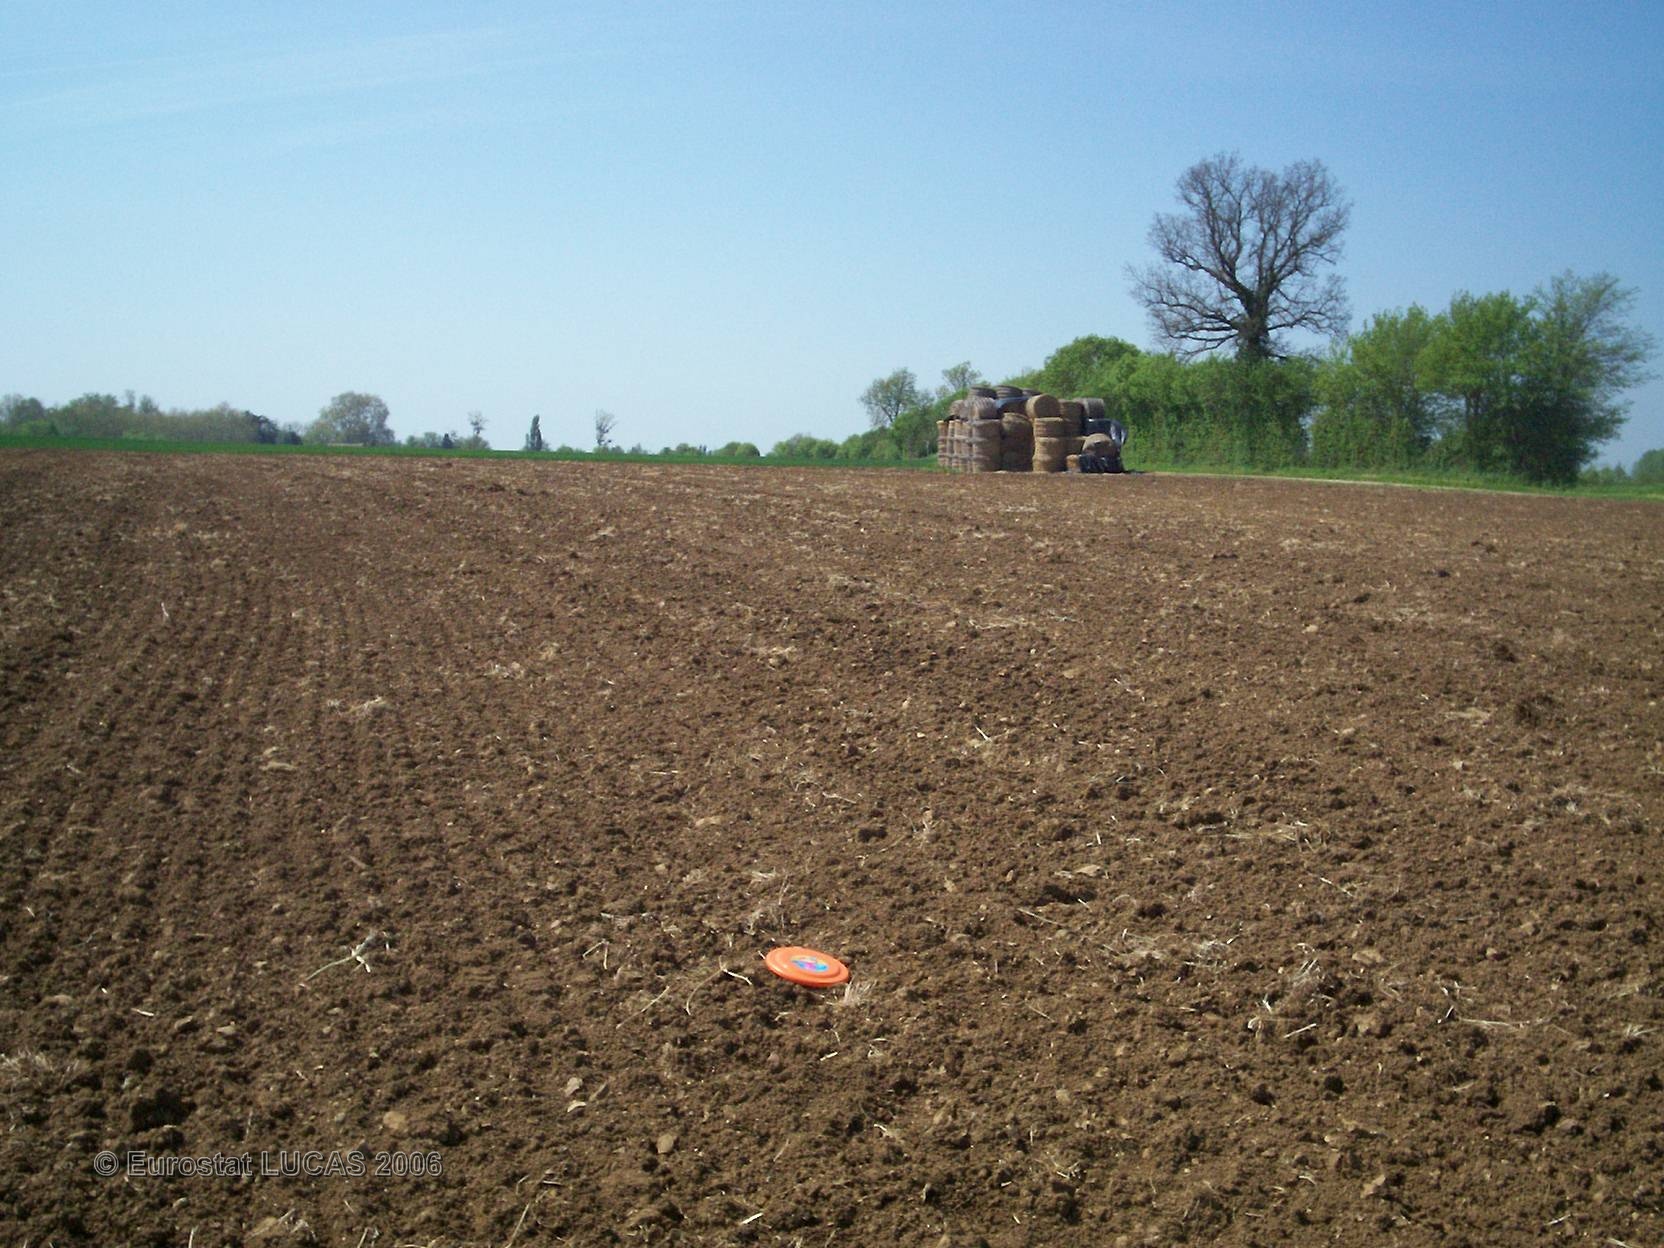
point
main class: Cropland
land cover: Sunflower
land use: Agriculture (excluding fallow land and kitchen gardens)
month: May
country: FR
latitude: 46.1669
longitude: -0.2411
